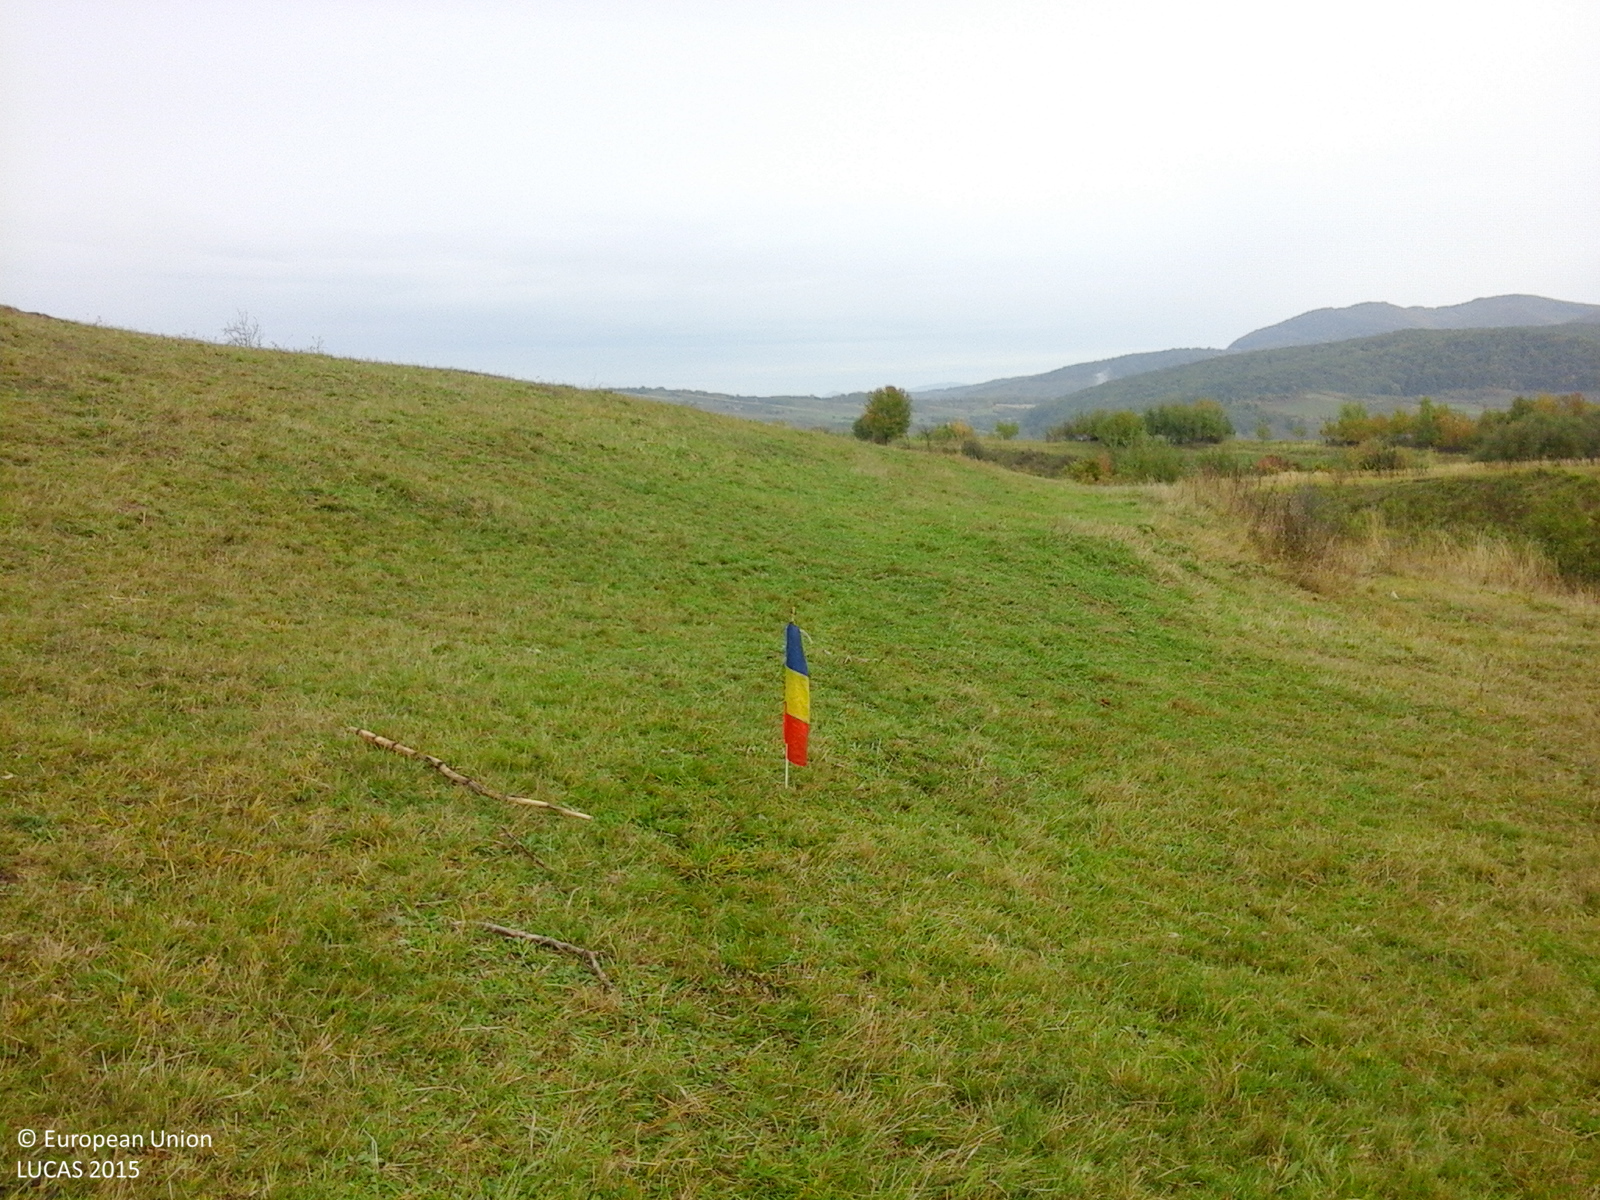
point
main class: Grassland
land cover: Grassland without tree/shrub cover
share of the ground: > 75 %
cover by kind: herbaceous plants 100 %
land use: Agriculture (excluding fallow land and kitchen gardens)
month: October
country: RO
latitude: 46.6508
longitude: 24.9273
